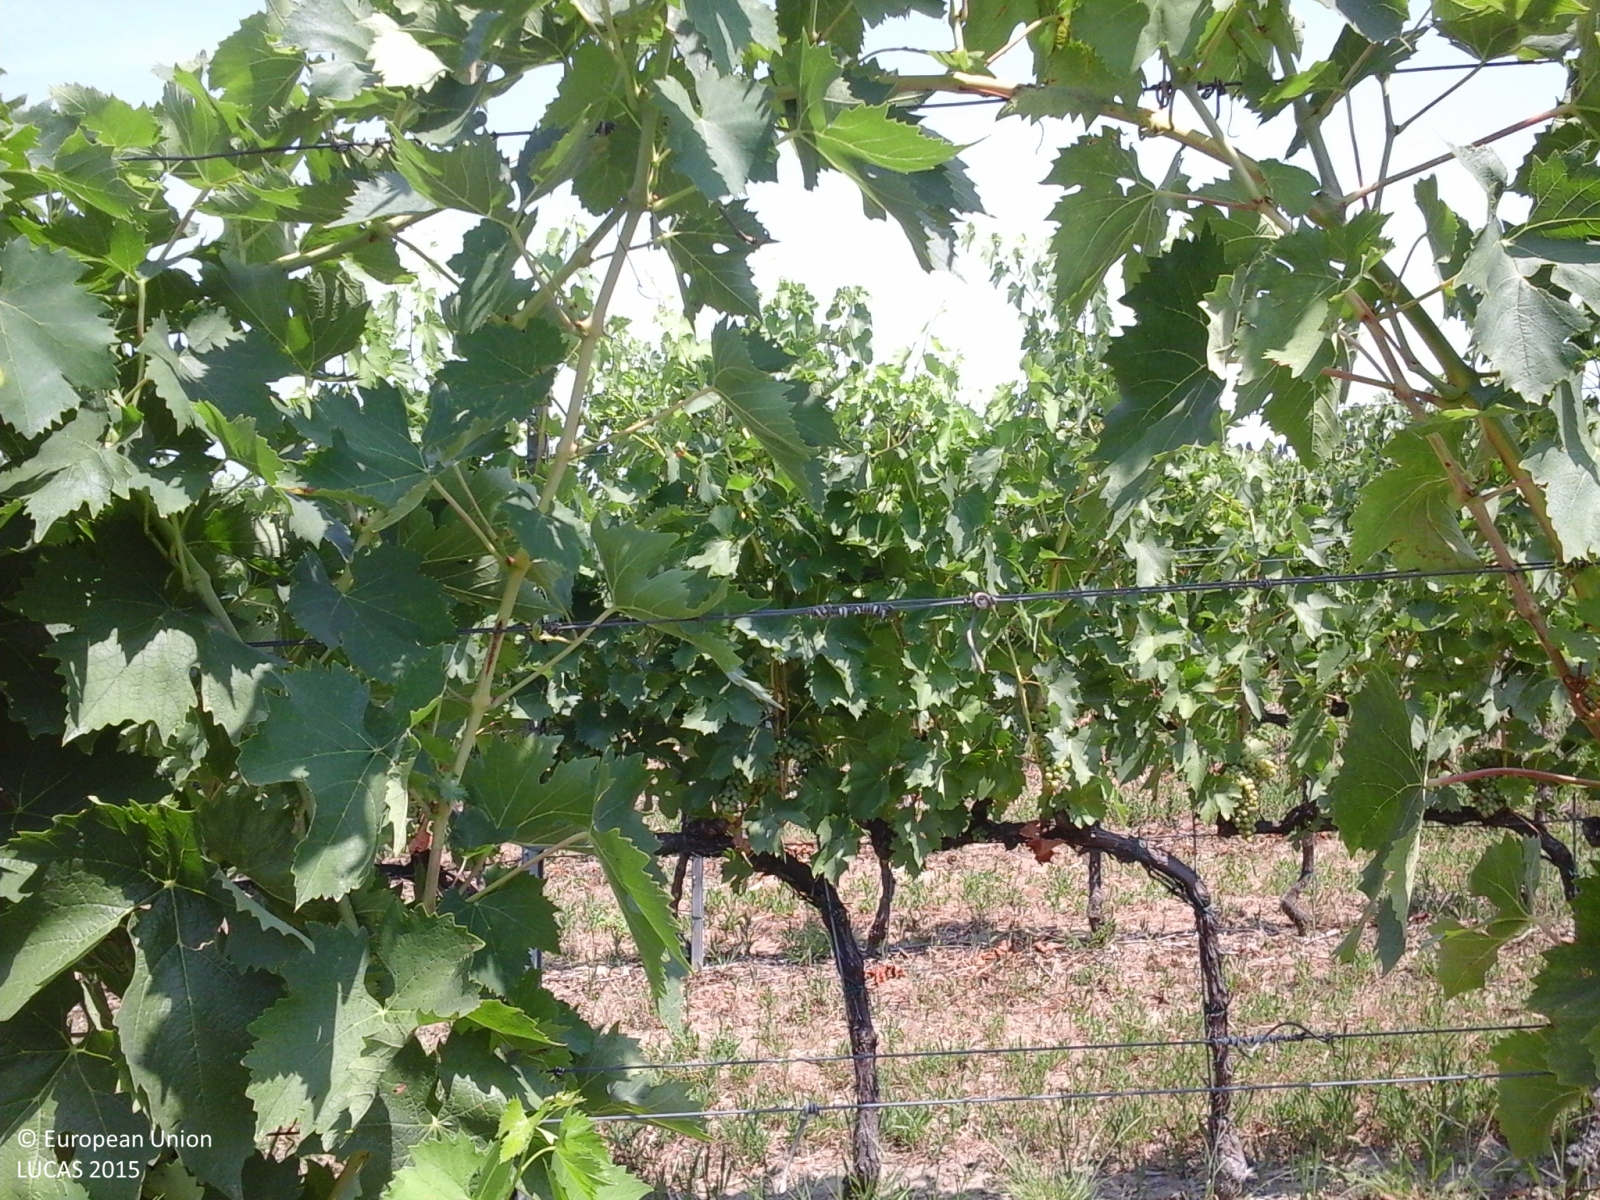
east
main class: Cropland
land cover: Vineyards
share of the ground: > 75 %
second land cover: Grassland without tree/shrub cover
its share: > 75 %
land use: Agriculture (excluding fallow land and kitchen gardens)
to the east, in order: Vineyards; Grassland without tree/shrub cover; Tracks; Vineyards
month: July
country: IT
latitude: 44.0707
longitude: 12.3793
